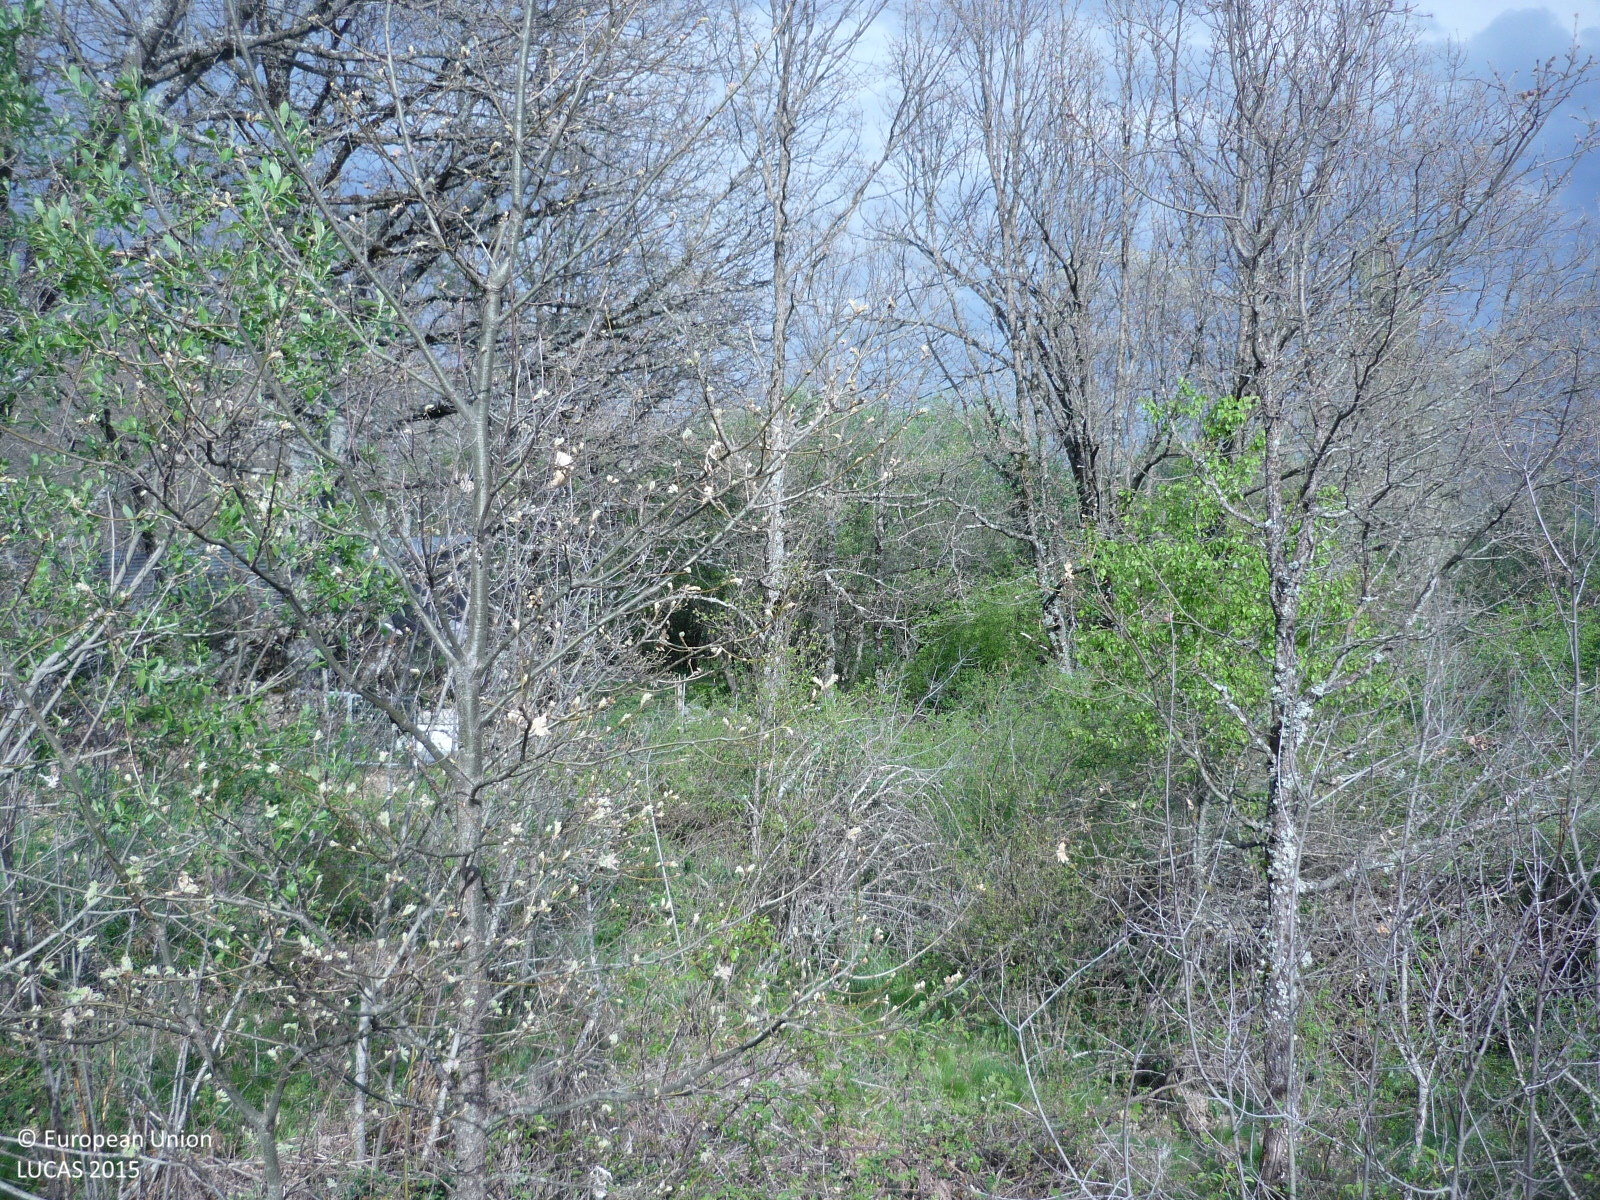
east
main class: Cropland
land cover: Apple fruit
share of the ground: 25 - 50 %
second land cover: Grassland without tree/shrub cover
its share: > 75 %
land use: Agriculture (excluding fallow land and kitchen gardens)
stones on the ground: < 10 %
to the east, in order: Apple fruit; Grassland without tree/shrub cover; Dry stone walls; Broadleaved woodland; Dry stone walls; Tracks; Dry stone walls; Grassland with sparse tree/shrub cover; Dry stone walls; Broadleaved woodland; Electric lines; Railways; Electric lines; Broadleaved woodland; Dry stone walls; Broadleaved woodland
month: May
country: ES
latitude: 41.0878
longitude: -3.6277
